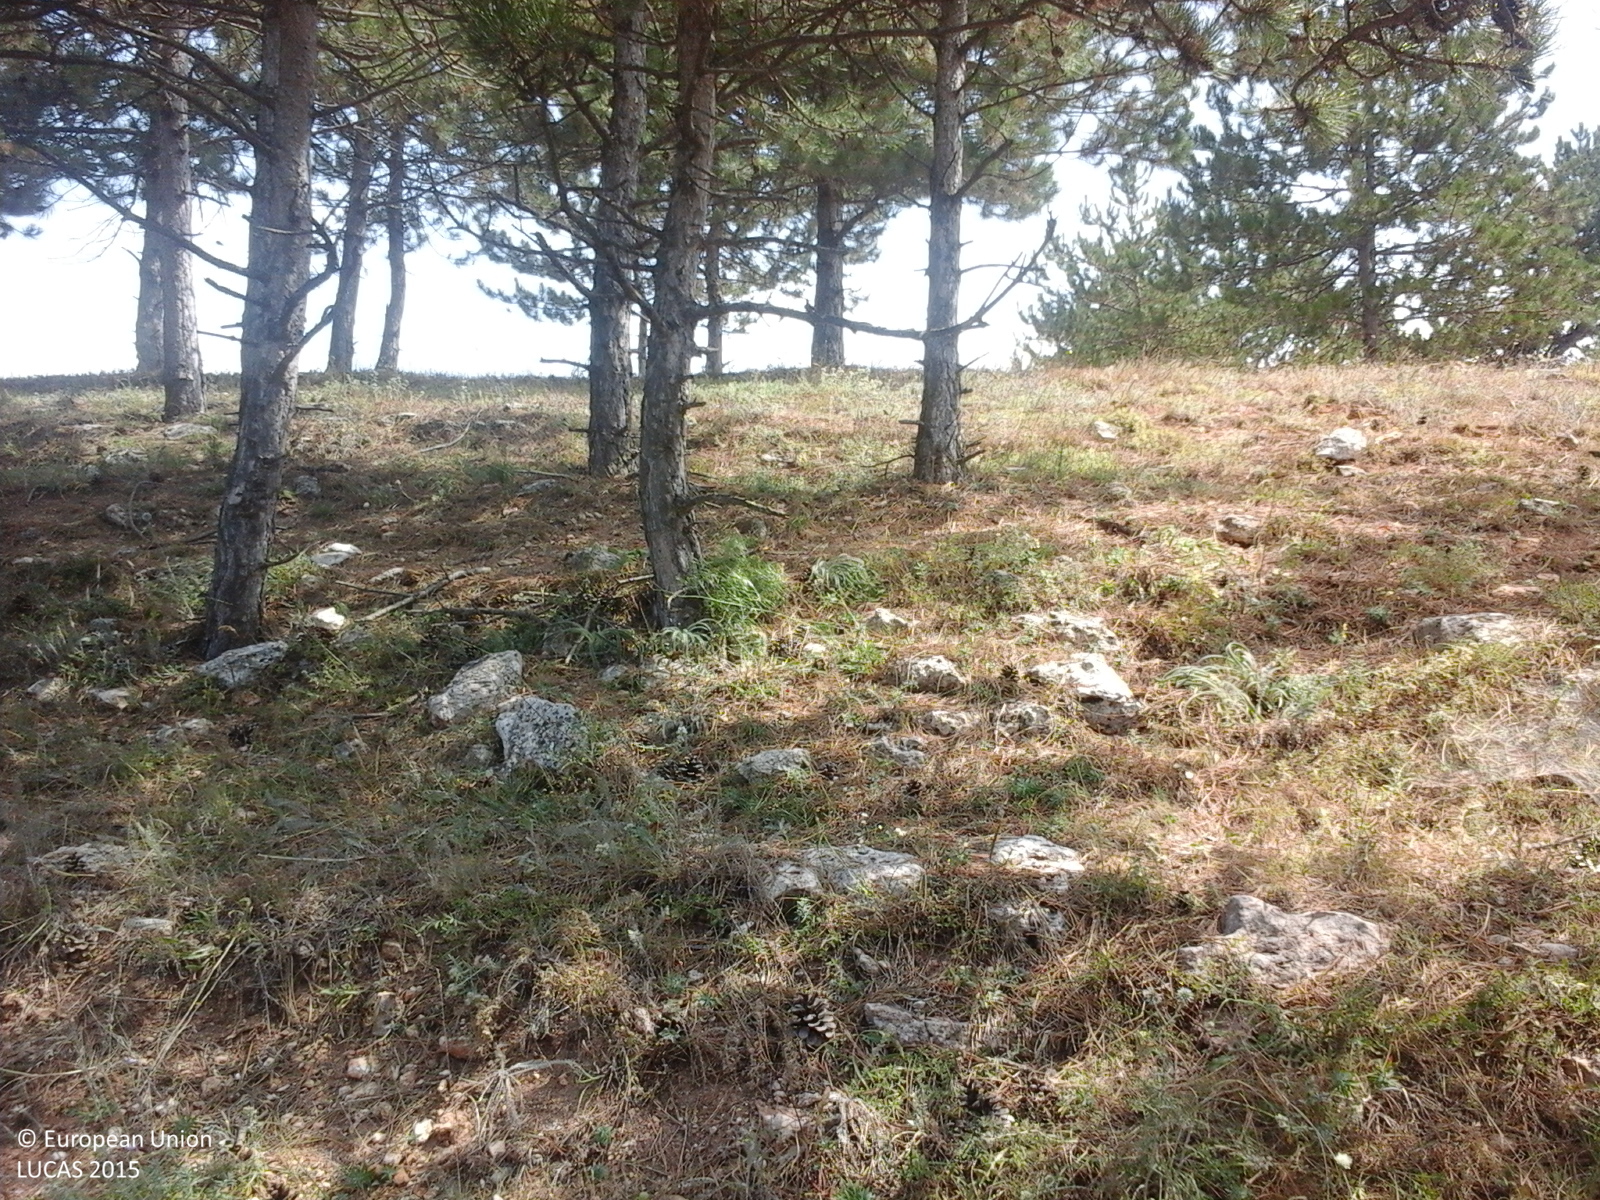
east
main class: Woodland
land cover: Pine dominated coniferous woodland
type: floodplain forest
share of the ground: 50 - 75 %
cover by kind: coniferous forest trees 90 %, herbaceous plants 10 %
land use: Forestry
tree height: > 5 m
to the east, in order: Pine dominated coniferous woodland; Shrubland with sparse tree cover; Grassland without tree/shrub cover
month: August
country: RO
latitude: 43.8093
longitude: 28.5267
